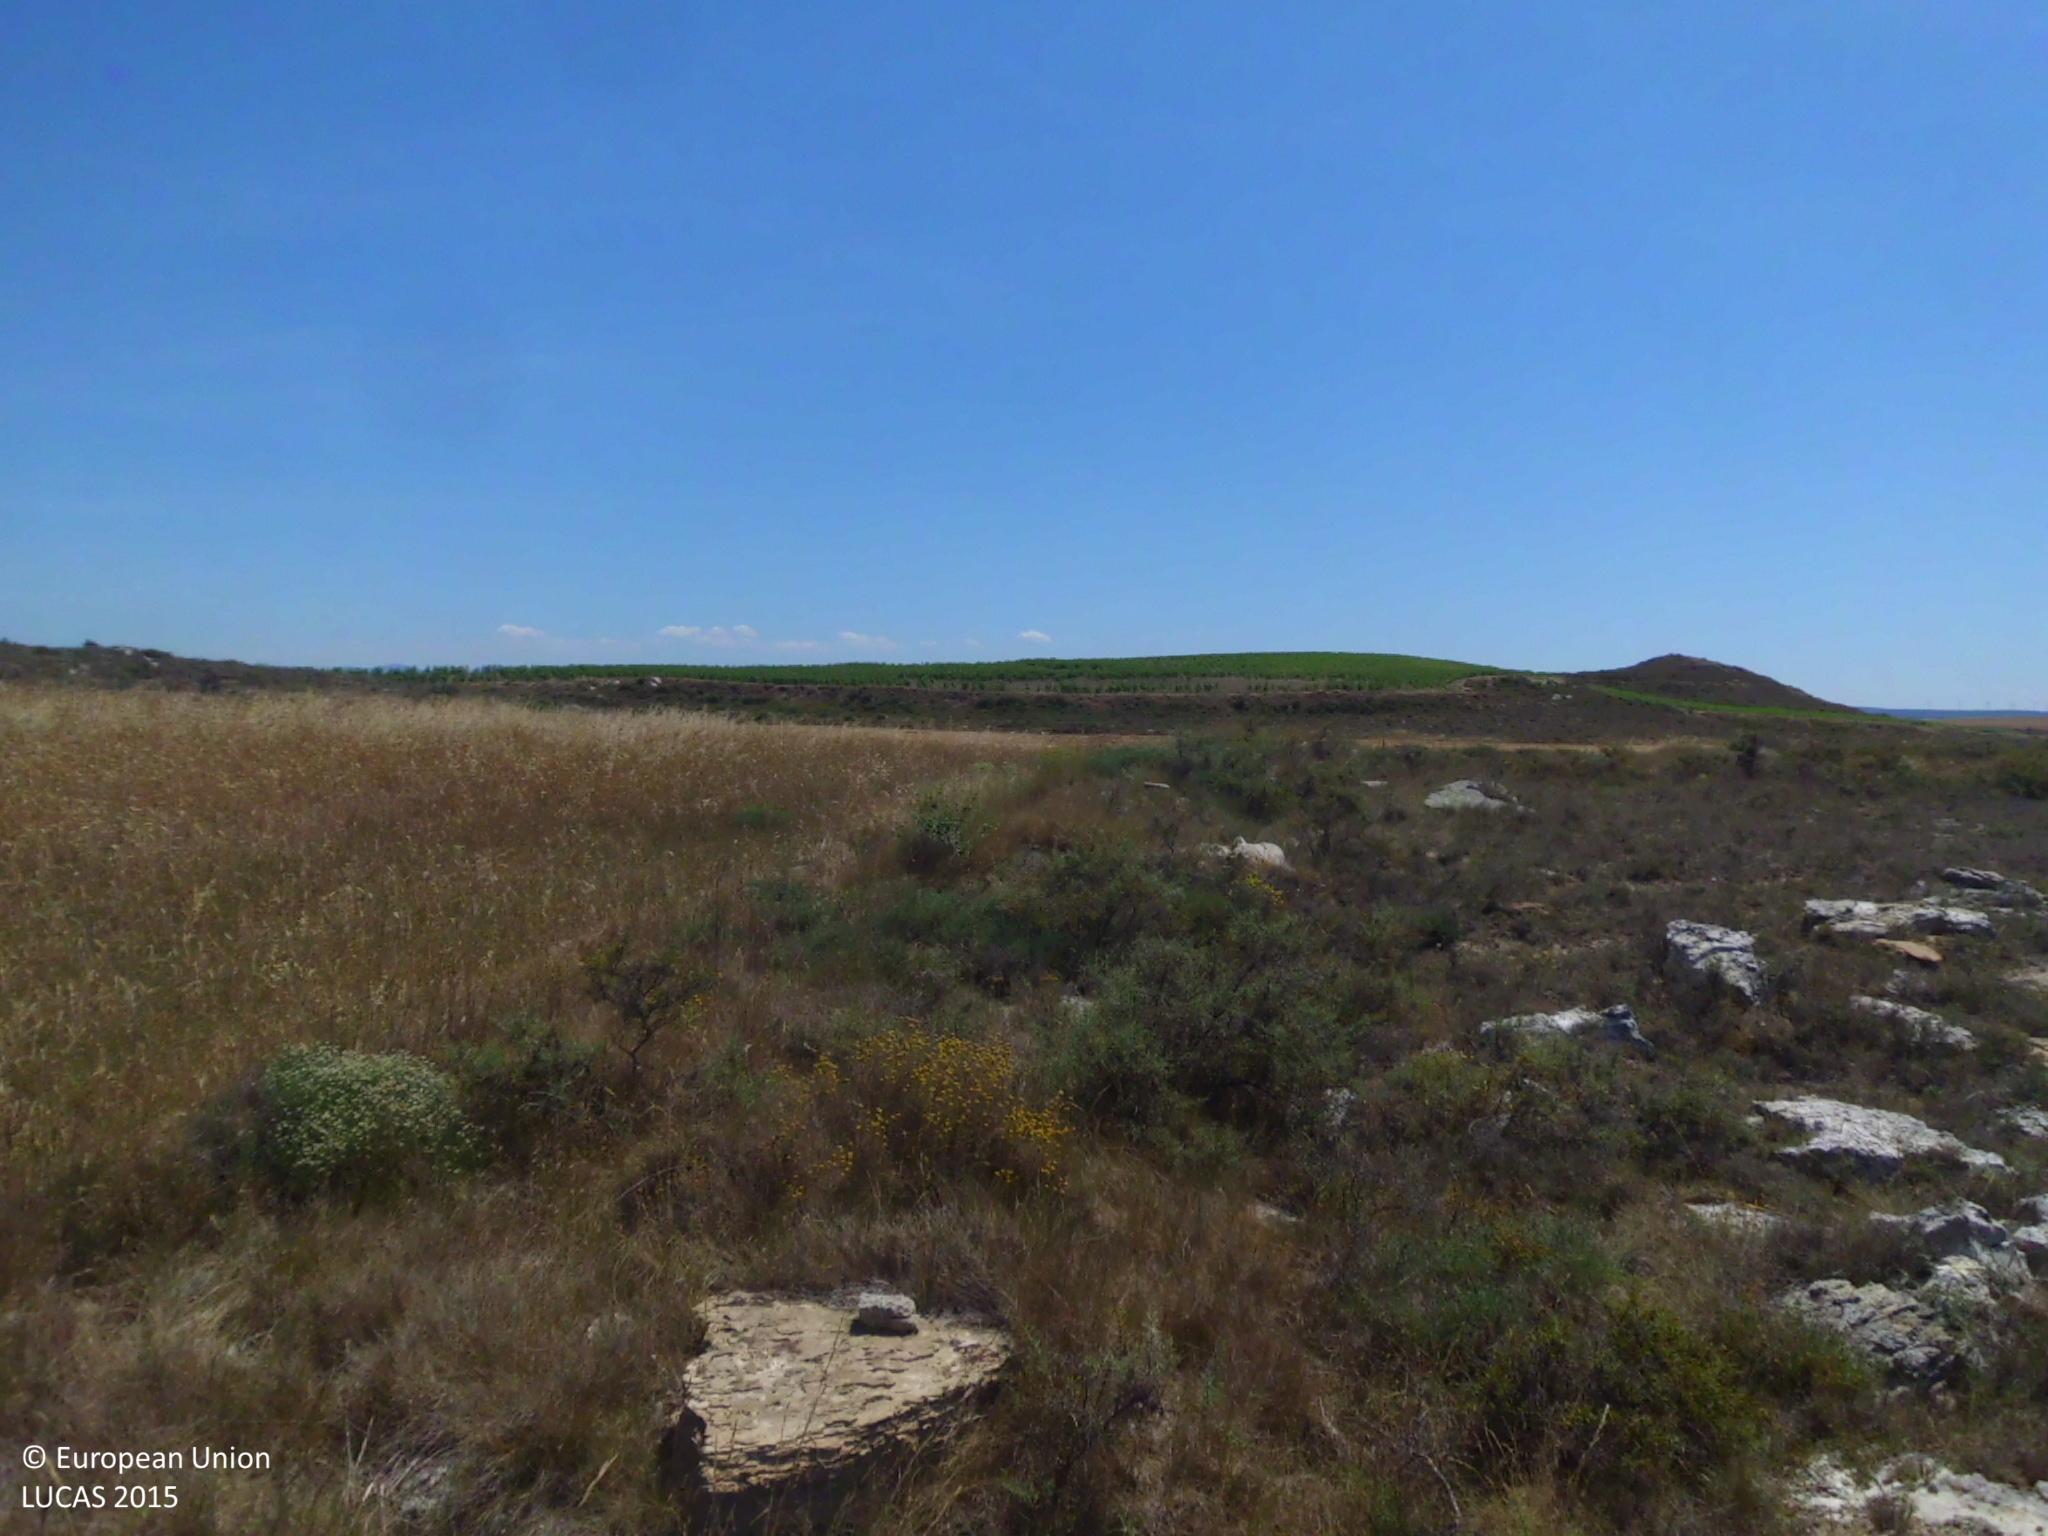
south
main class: Shrubland
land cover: Shrubland without tree cover
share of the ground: 50 - 75 %
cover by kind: shrubs 50 %, unconsolidated bare surface 35 %, herbaceous plants 15 %
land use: Semi-natural and natural areas not in use
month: July
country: ES
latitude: 42.4848
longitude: -3.3045
